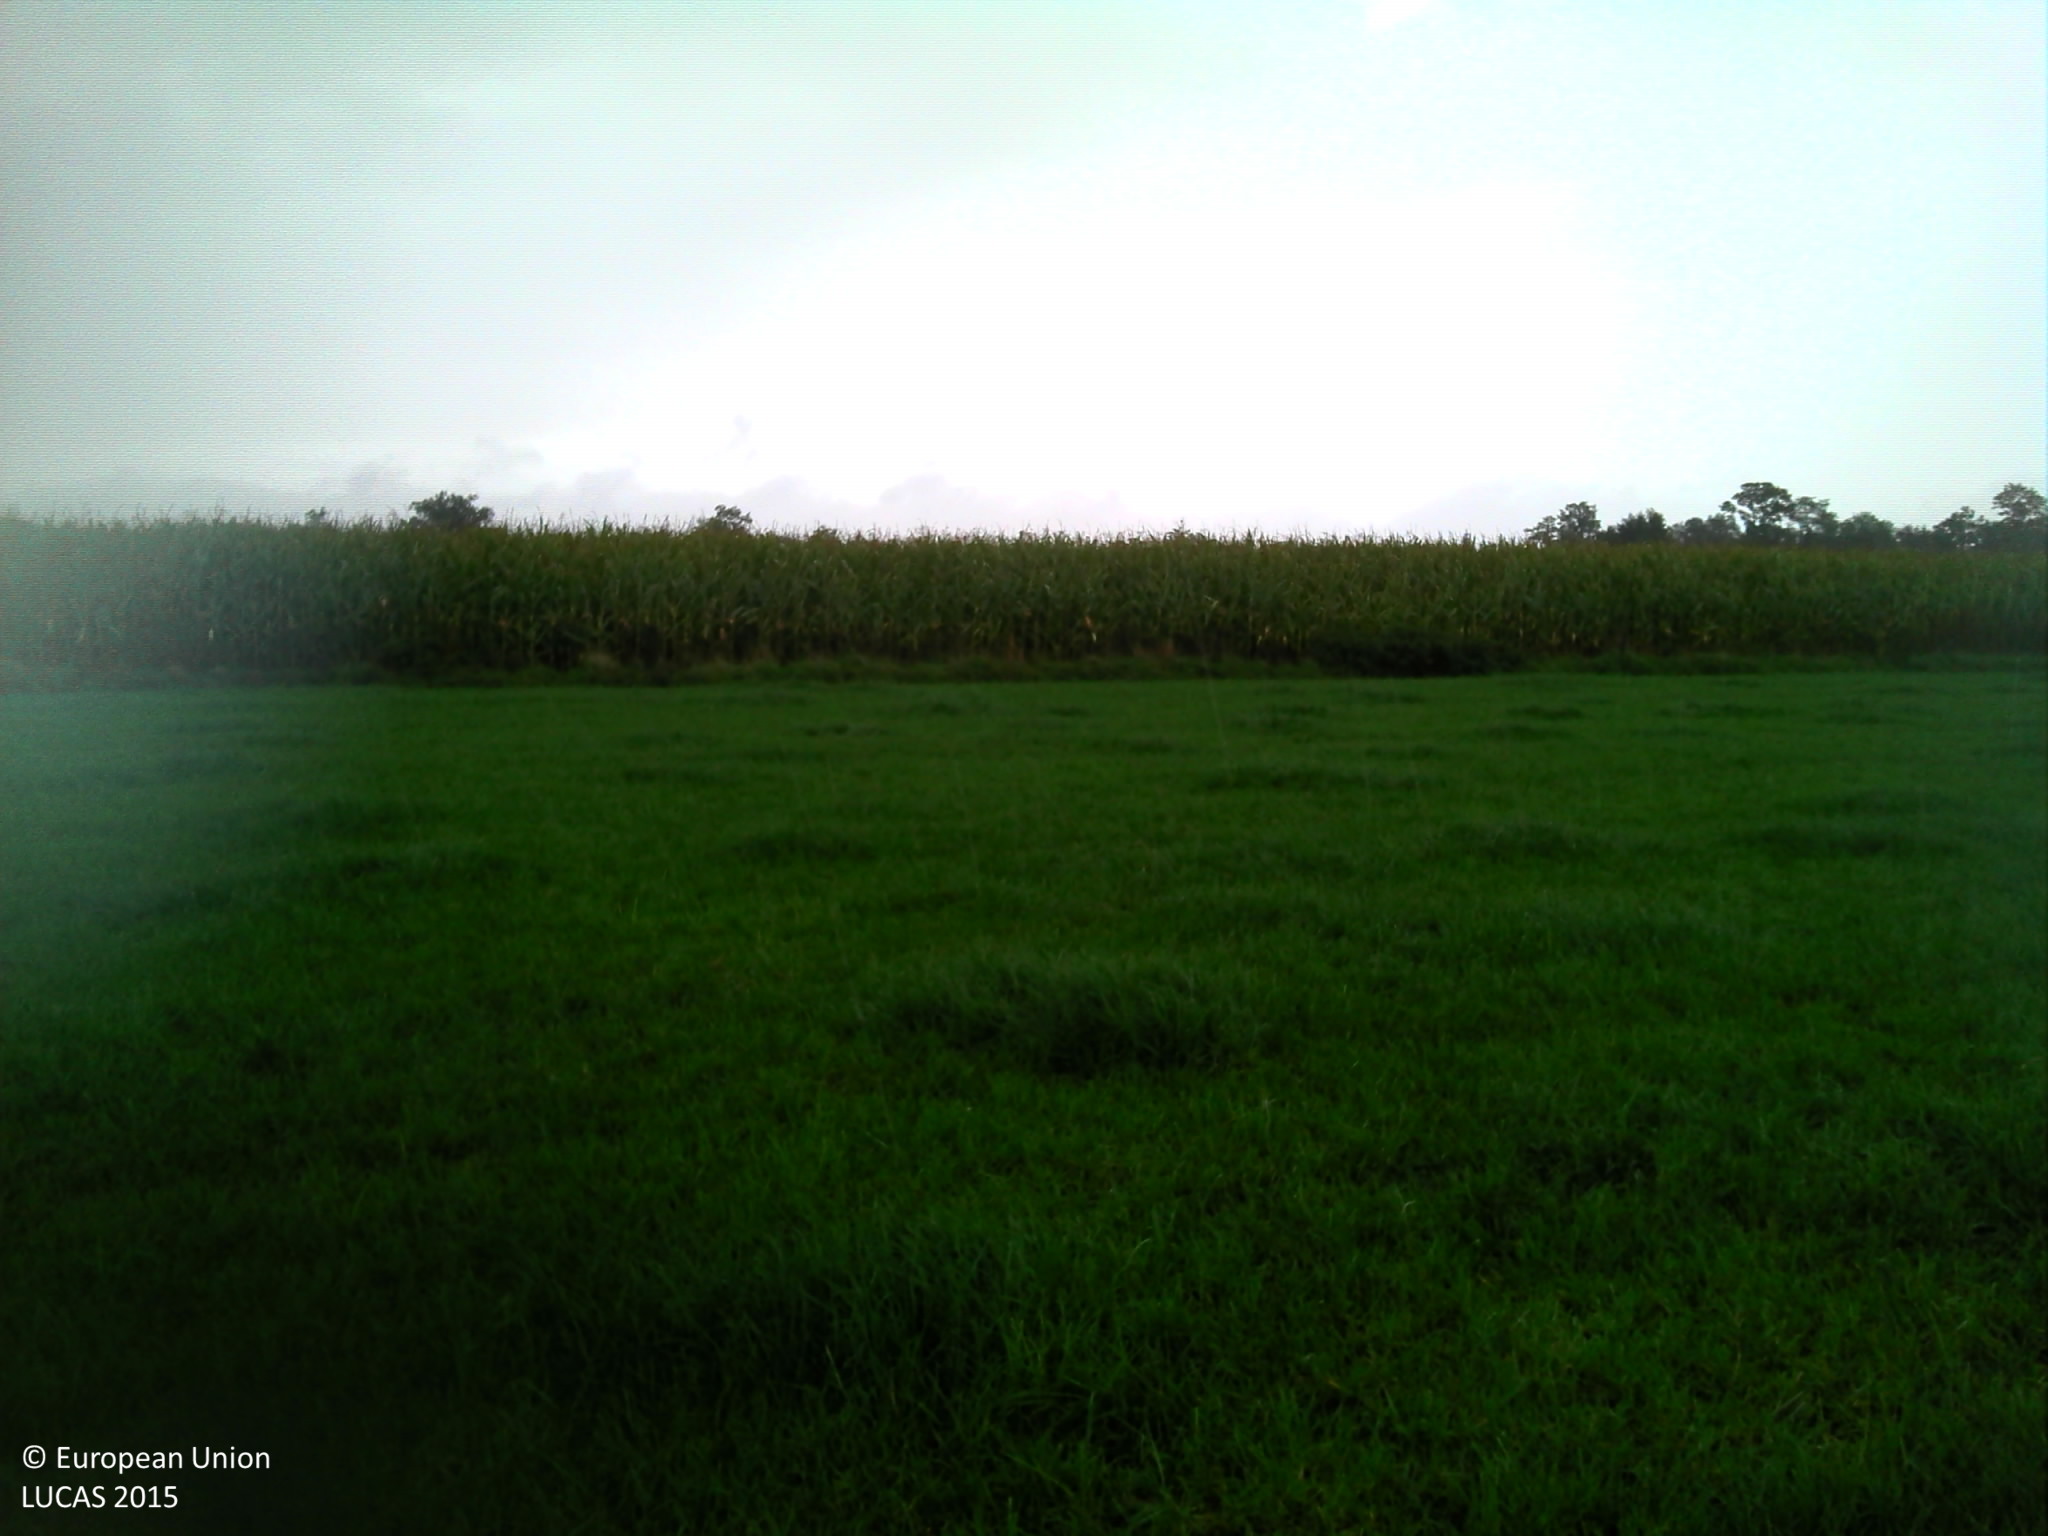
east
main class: Cropland
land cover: Temporary grasslands
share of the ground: > 75 %
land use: Agriculture (excluding fallow land and kitchen gardens)
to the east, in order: Temporary grasslands; Fences; Grass margins; Maize
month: September
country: BE
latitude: 51.3608
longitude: 4.7545
